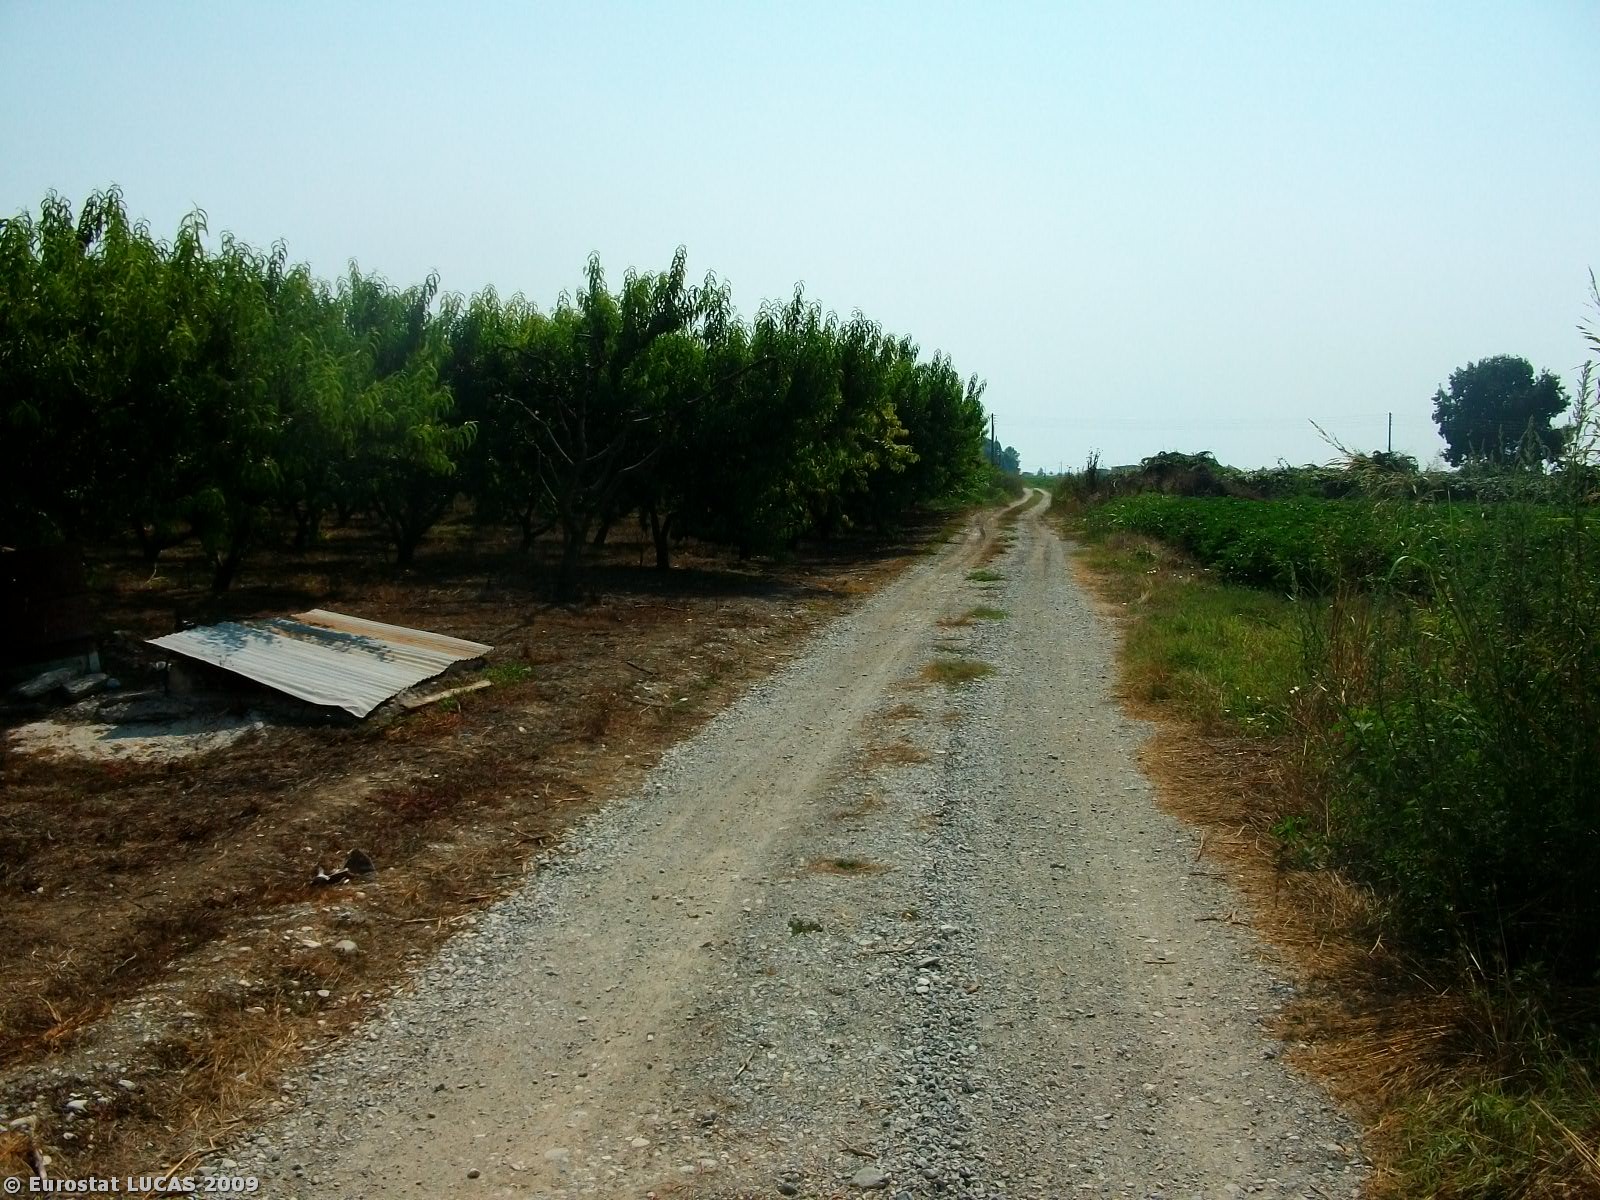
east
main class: Artificial land
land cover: Non built-up linear features
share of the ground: > 75 %
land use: Road transport
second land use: Agriculture (excluding fallow land and kitchen gardens)
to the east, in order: Bare land; Grass margins; Other fruit trees and berries; Grassland with sparse tree/shrub cover; Maize; Other fruit trees and berries; Grassland with sparse tree/shrub cover
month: July
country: GR
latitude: 40.2929
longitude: 22.5983
